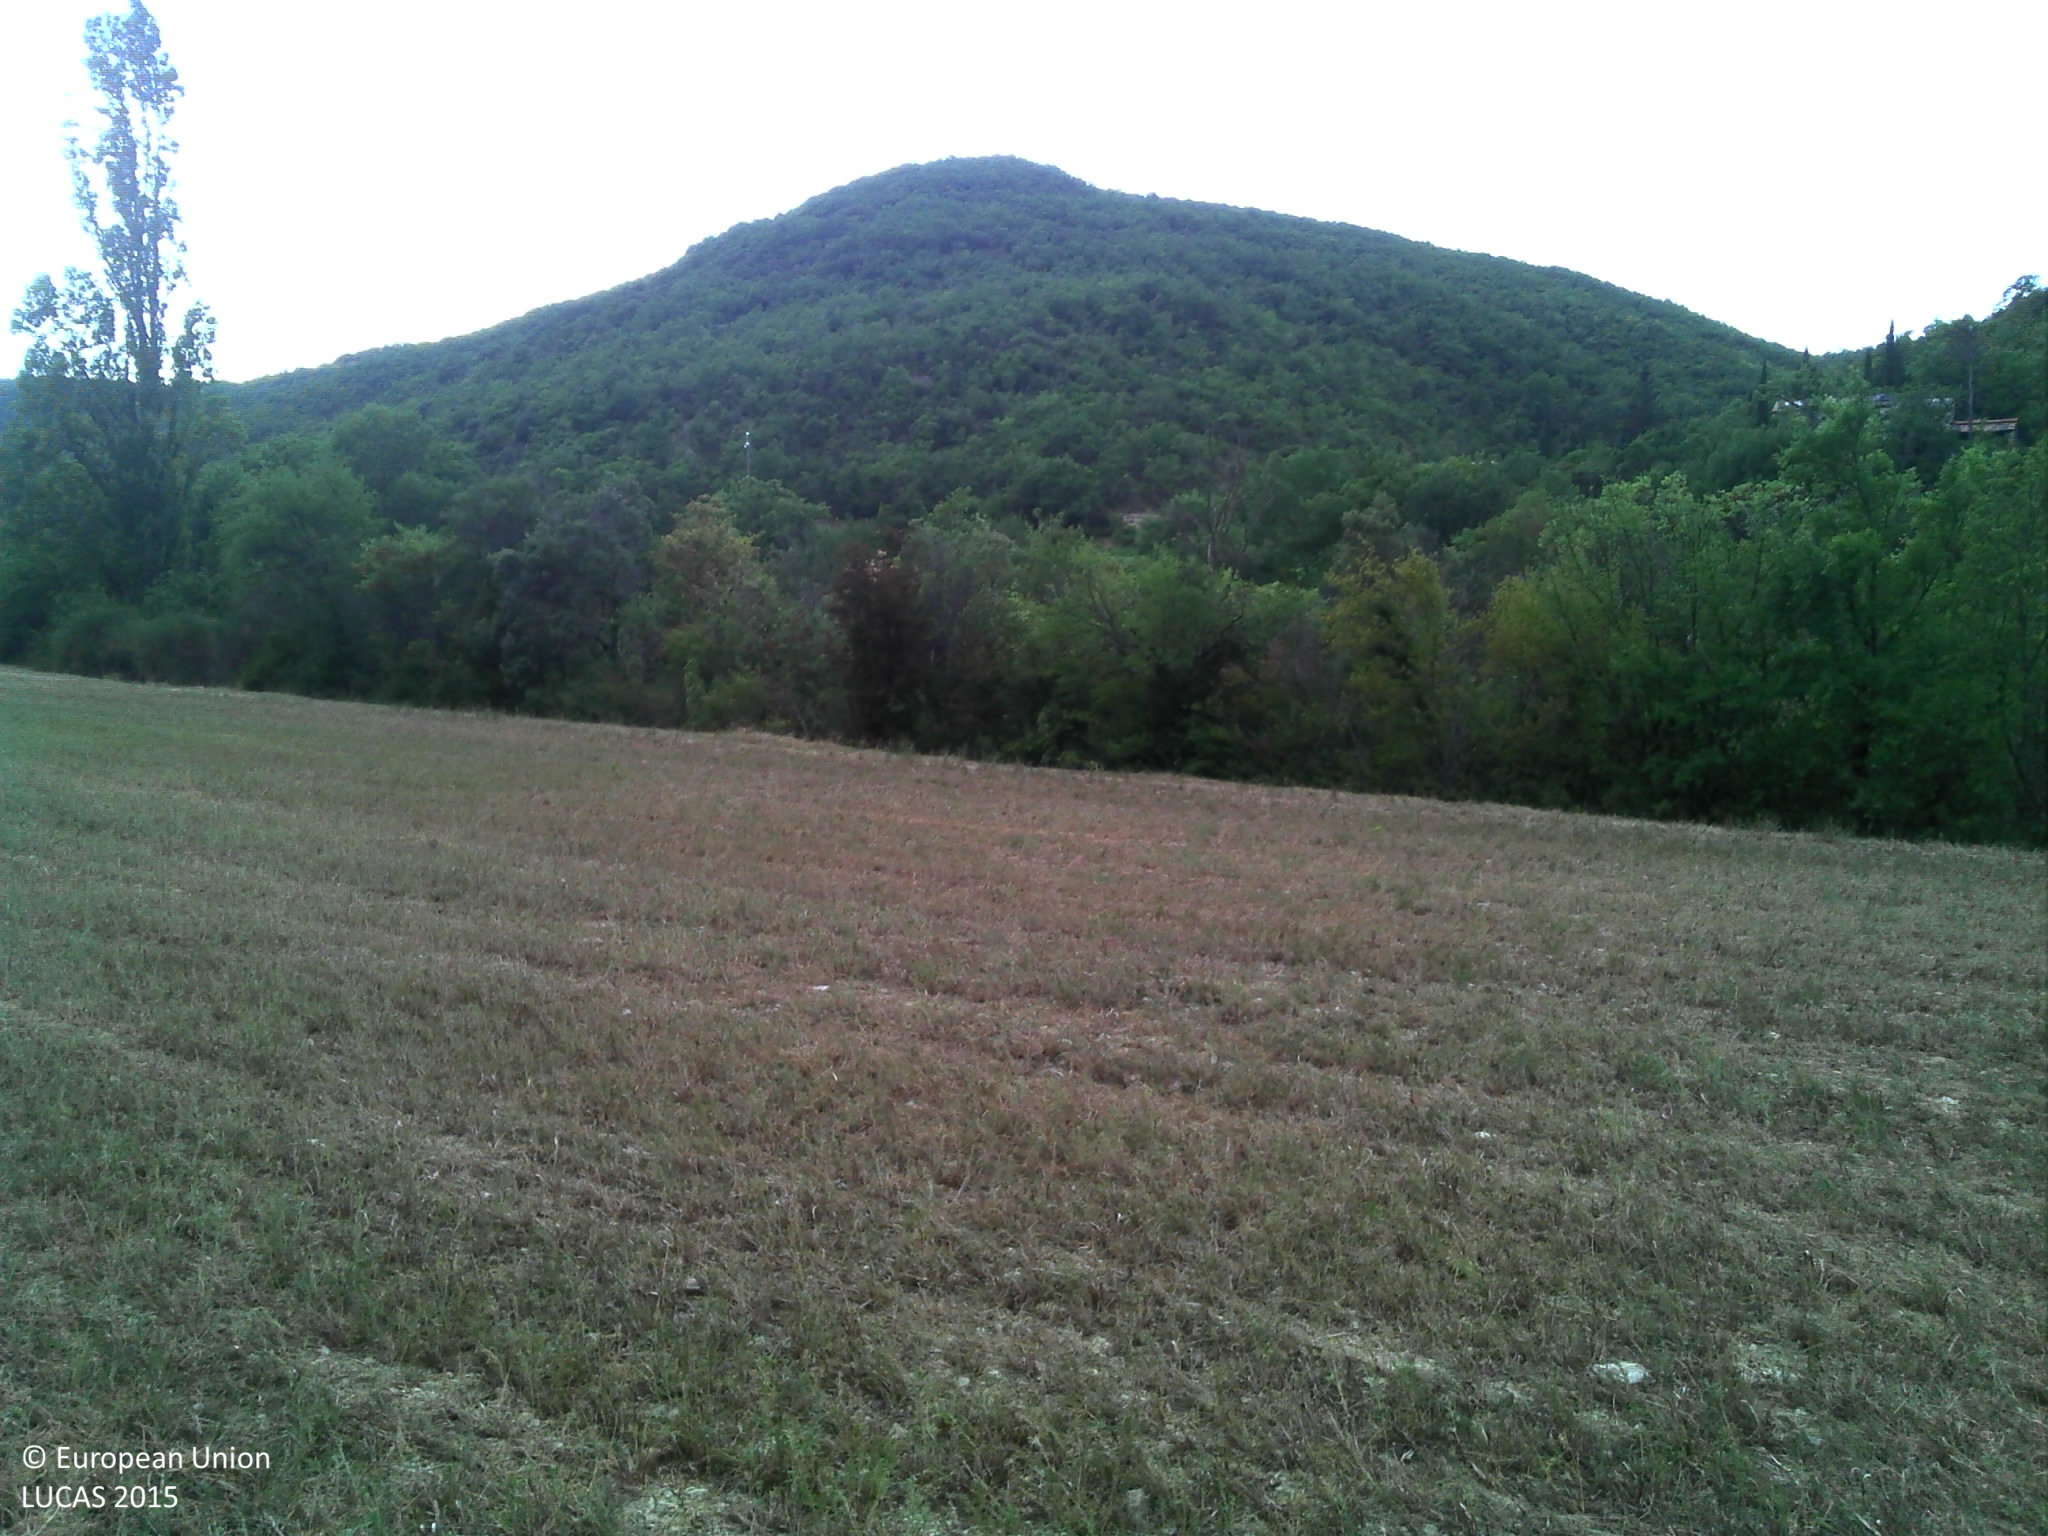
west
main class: Woodland
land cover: Broadleaved woodland
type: broadleaved evergreen forest
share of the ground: > 75 %
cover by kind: broadleaved forest trees 90 %, herbaceous plants 10 %
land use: Semi-natural and natural areas not in use
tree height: > 5 m
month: July
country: FR
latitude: 44.4817
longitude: 4.6130
